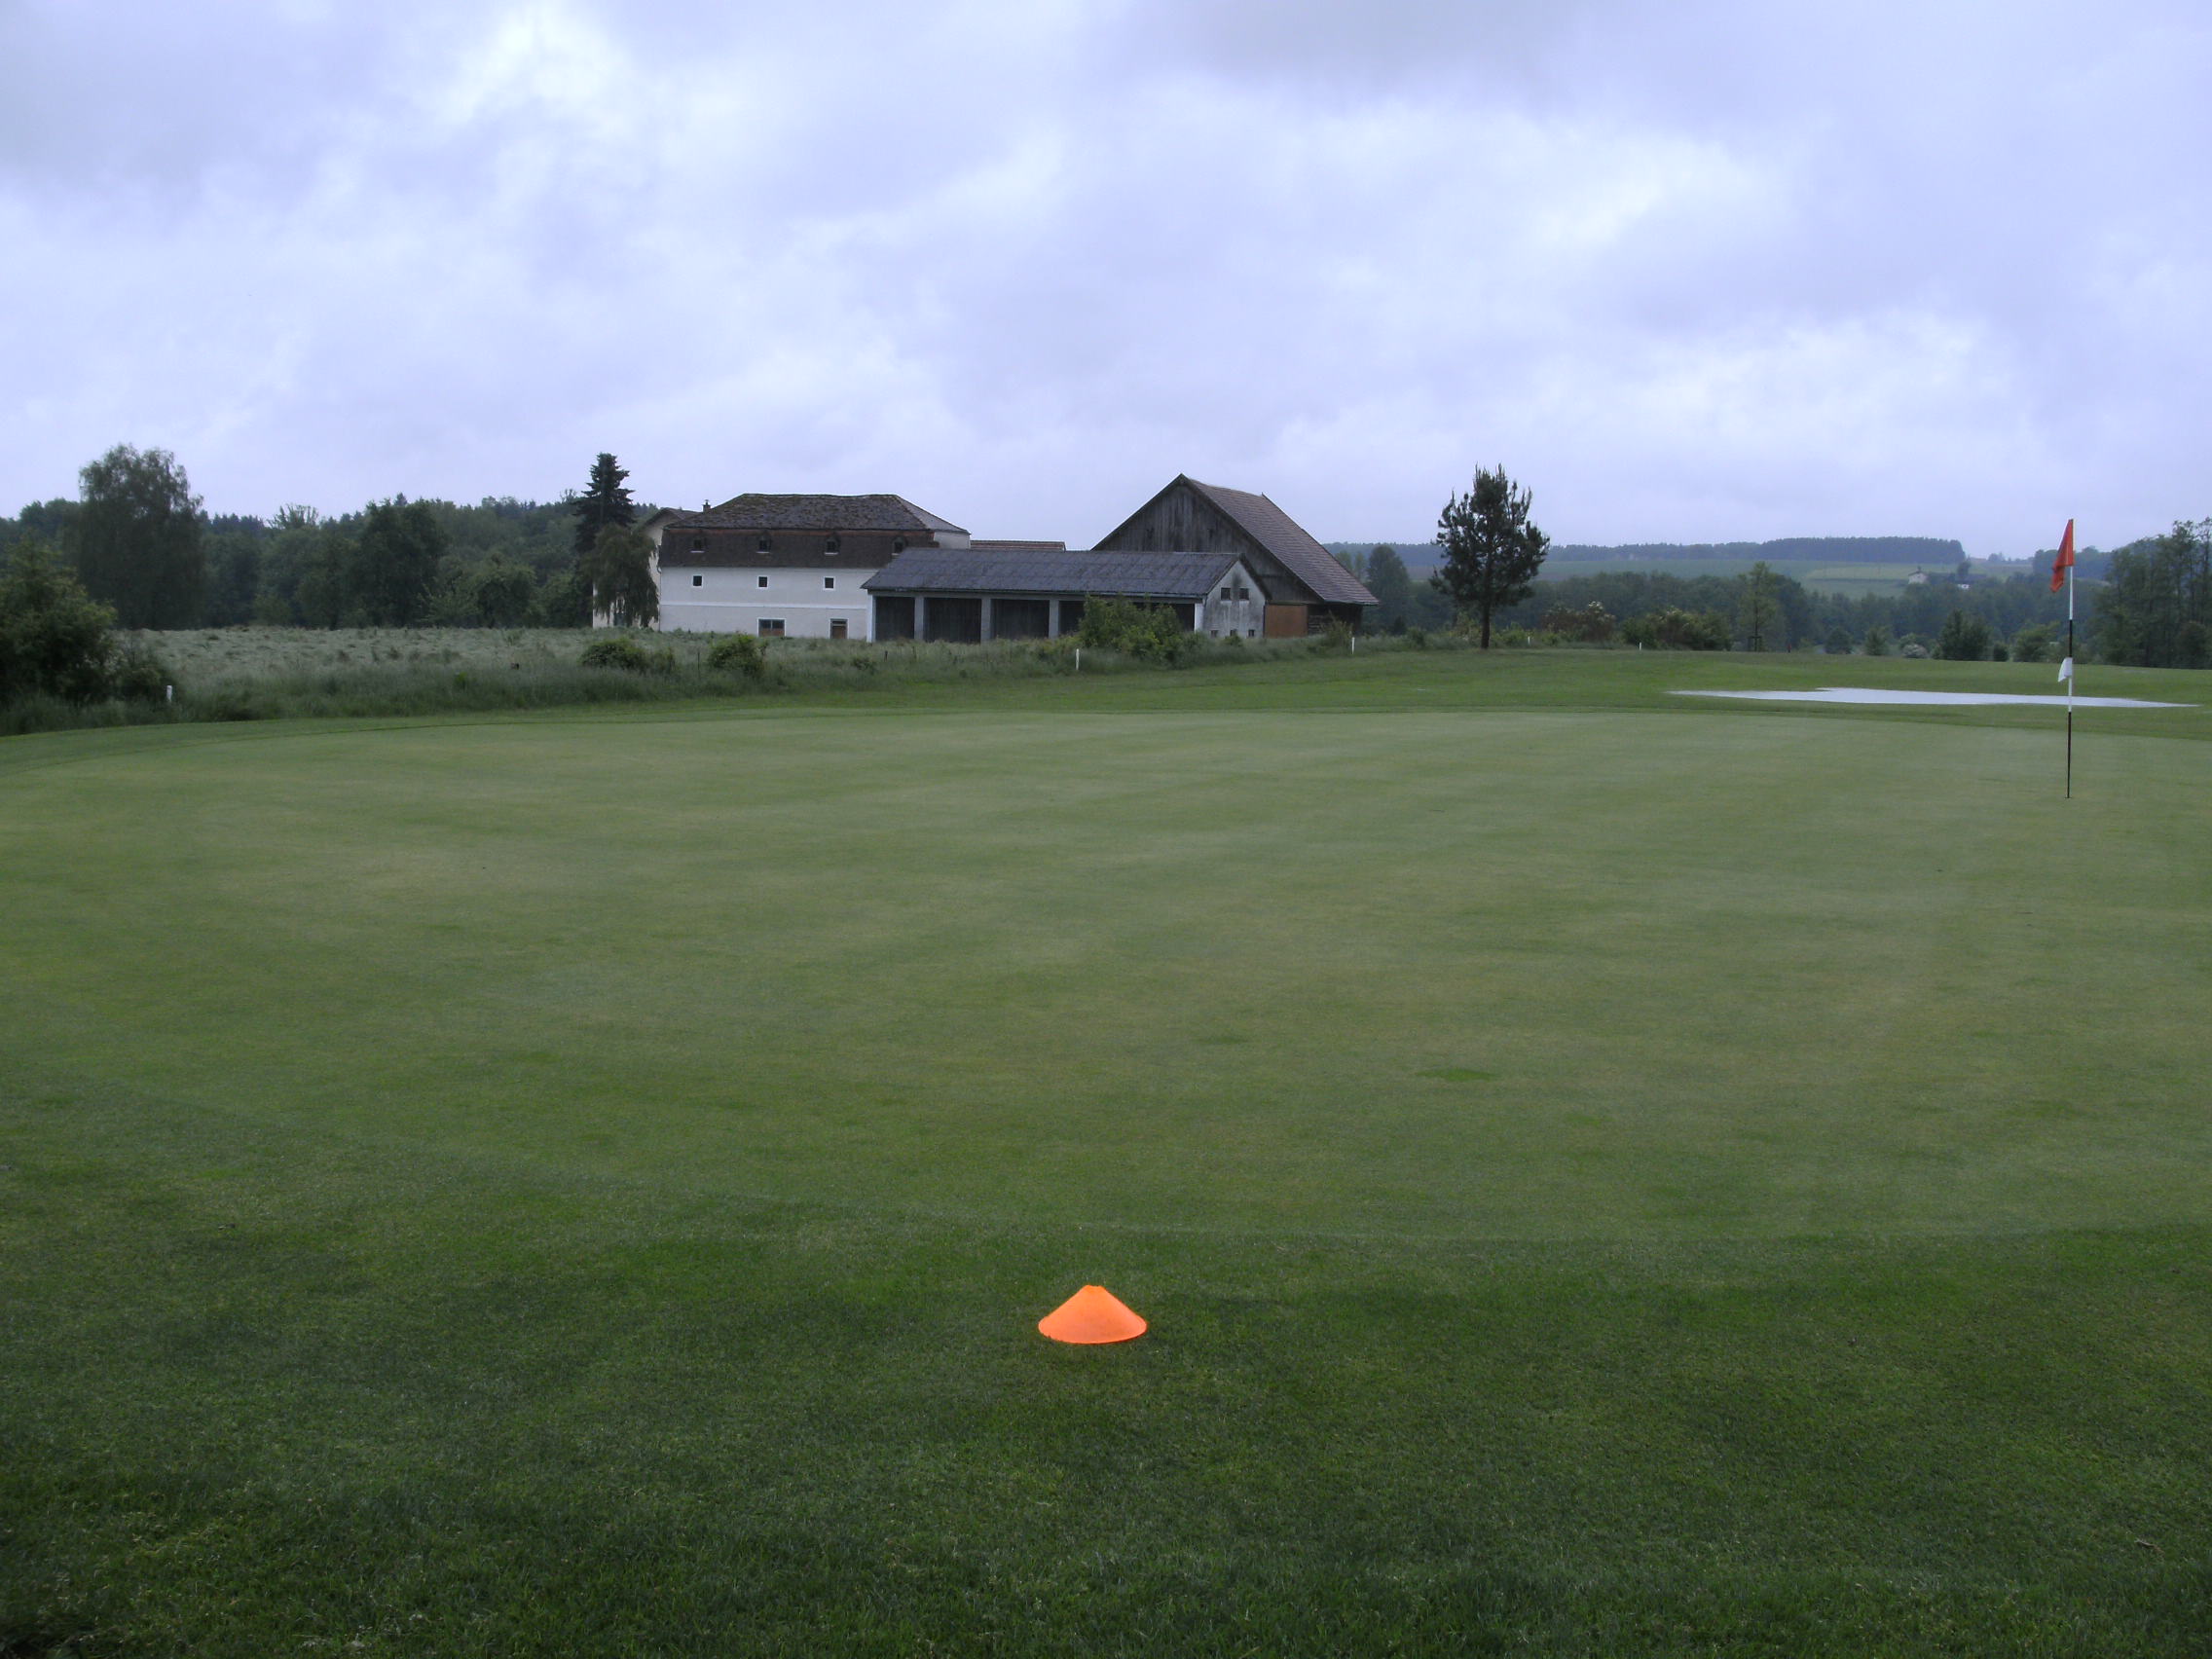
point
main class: Grassland
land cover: Grassland without tree/shrub cover
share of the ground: > 75 %
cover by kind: herbaceous plants 100 %
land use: Sport
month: May
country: AT
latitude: 48.3834
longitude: 13.5237
